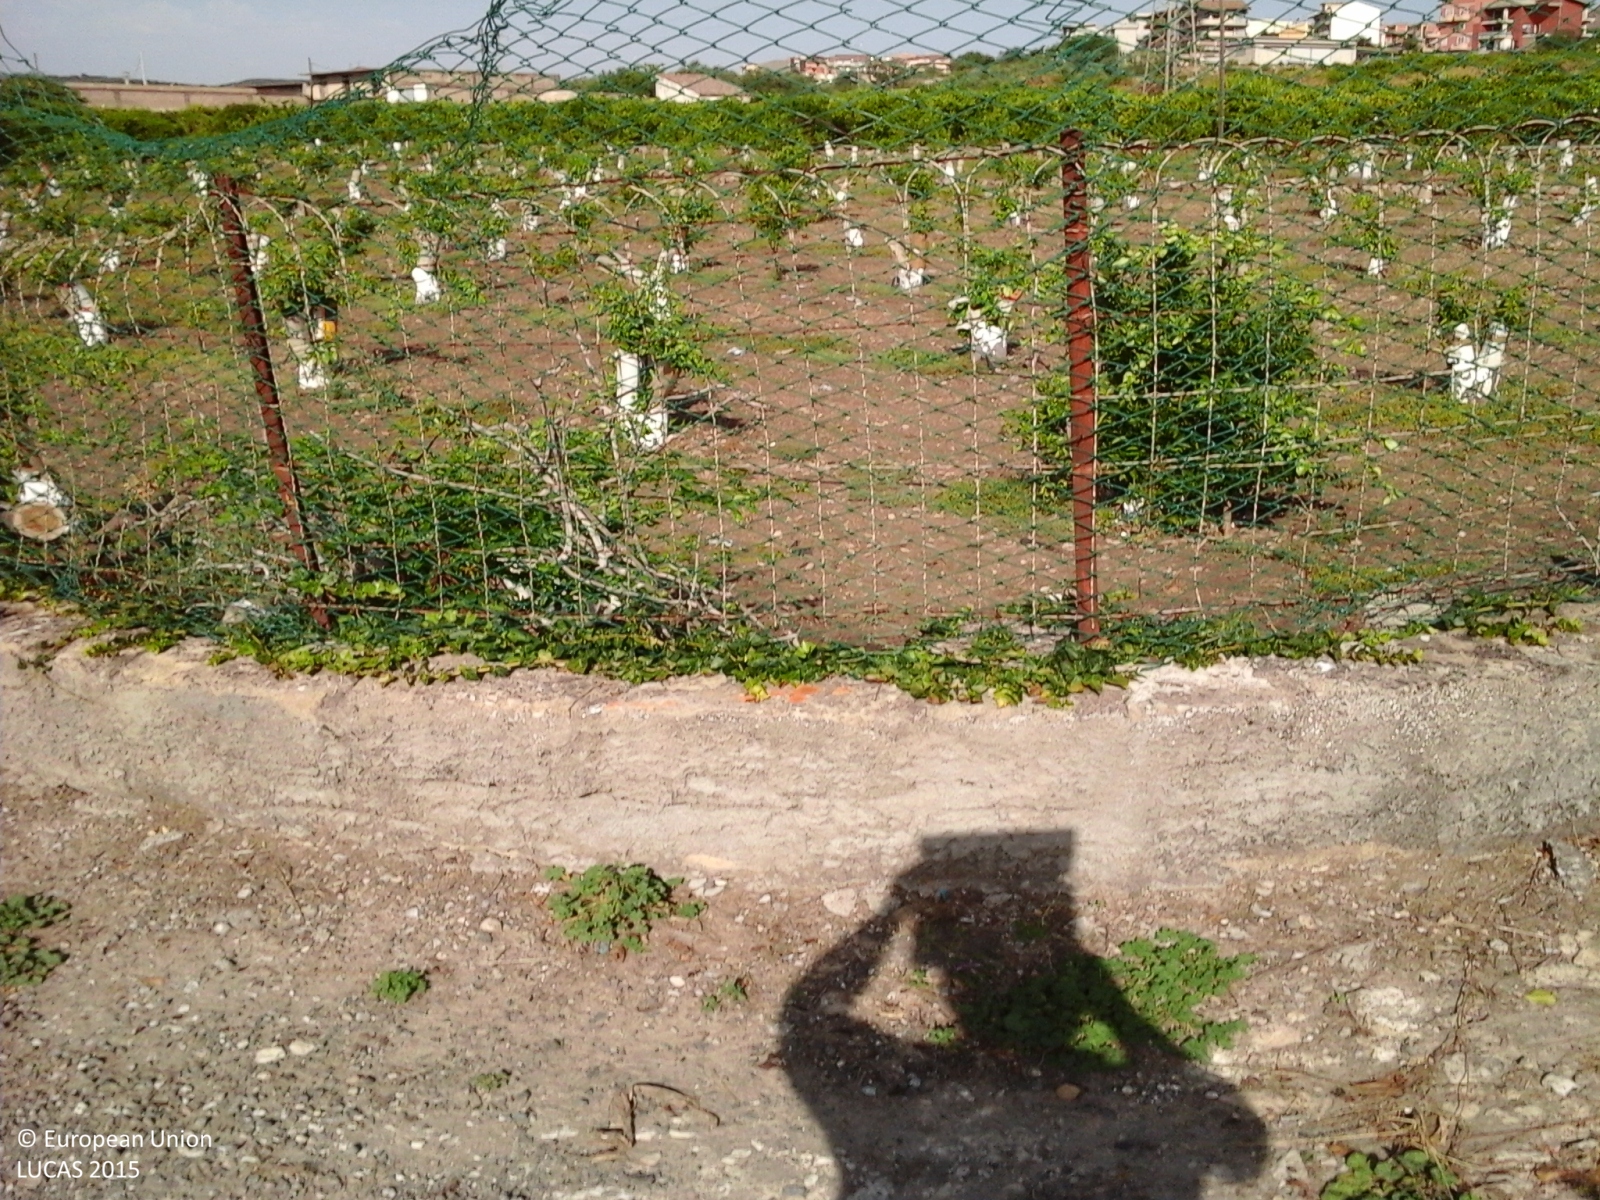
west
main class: Cropland
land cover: Oranges
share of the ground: > 75 %
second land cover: Spontaneously vegetated surfaces
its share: > 75 %
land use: Agriculture (excluding fallow land and kitchen gardens)
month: August
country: IT
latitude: 37.2217
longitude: 14.8880
